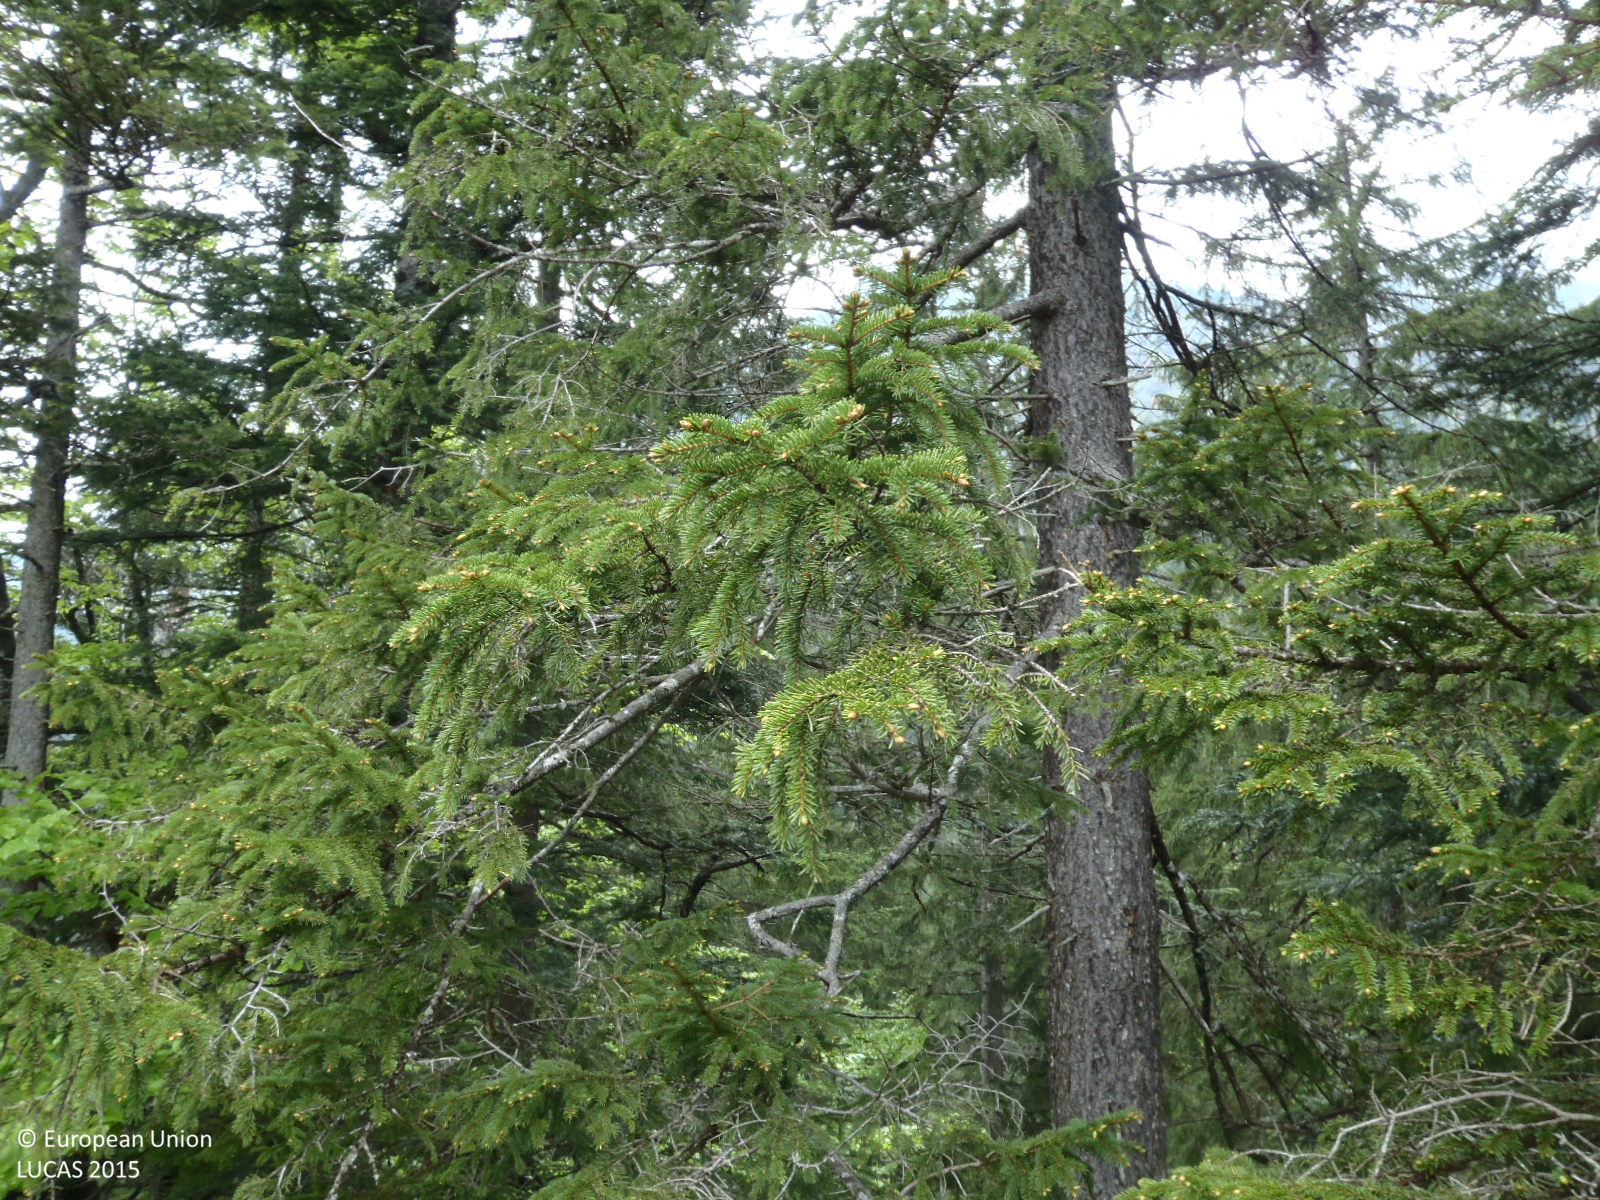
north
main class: Grassland
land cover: Grassland with sparse tree/shrub cover
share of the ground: > 75 %
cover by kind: herbaceous plants 55 %, unconsolidated bare surface 35 %, coniferous forest trees 5 %, shrubs 5 %
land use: Semi-natural and natural areas not in use
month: May
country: AT
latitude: 47.4382
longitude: 11.5766
